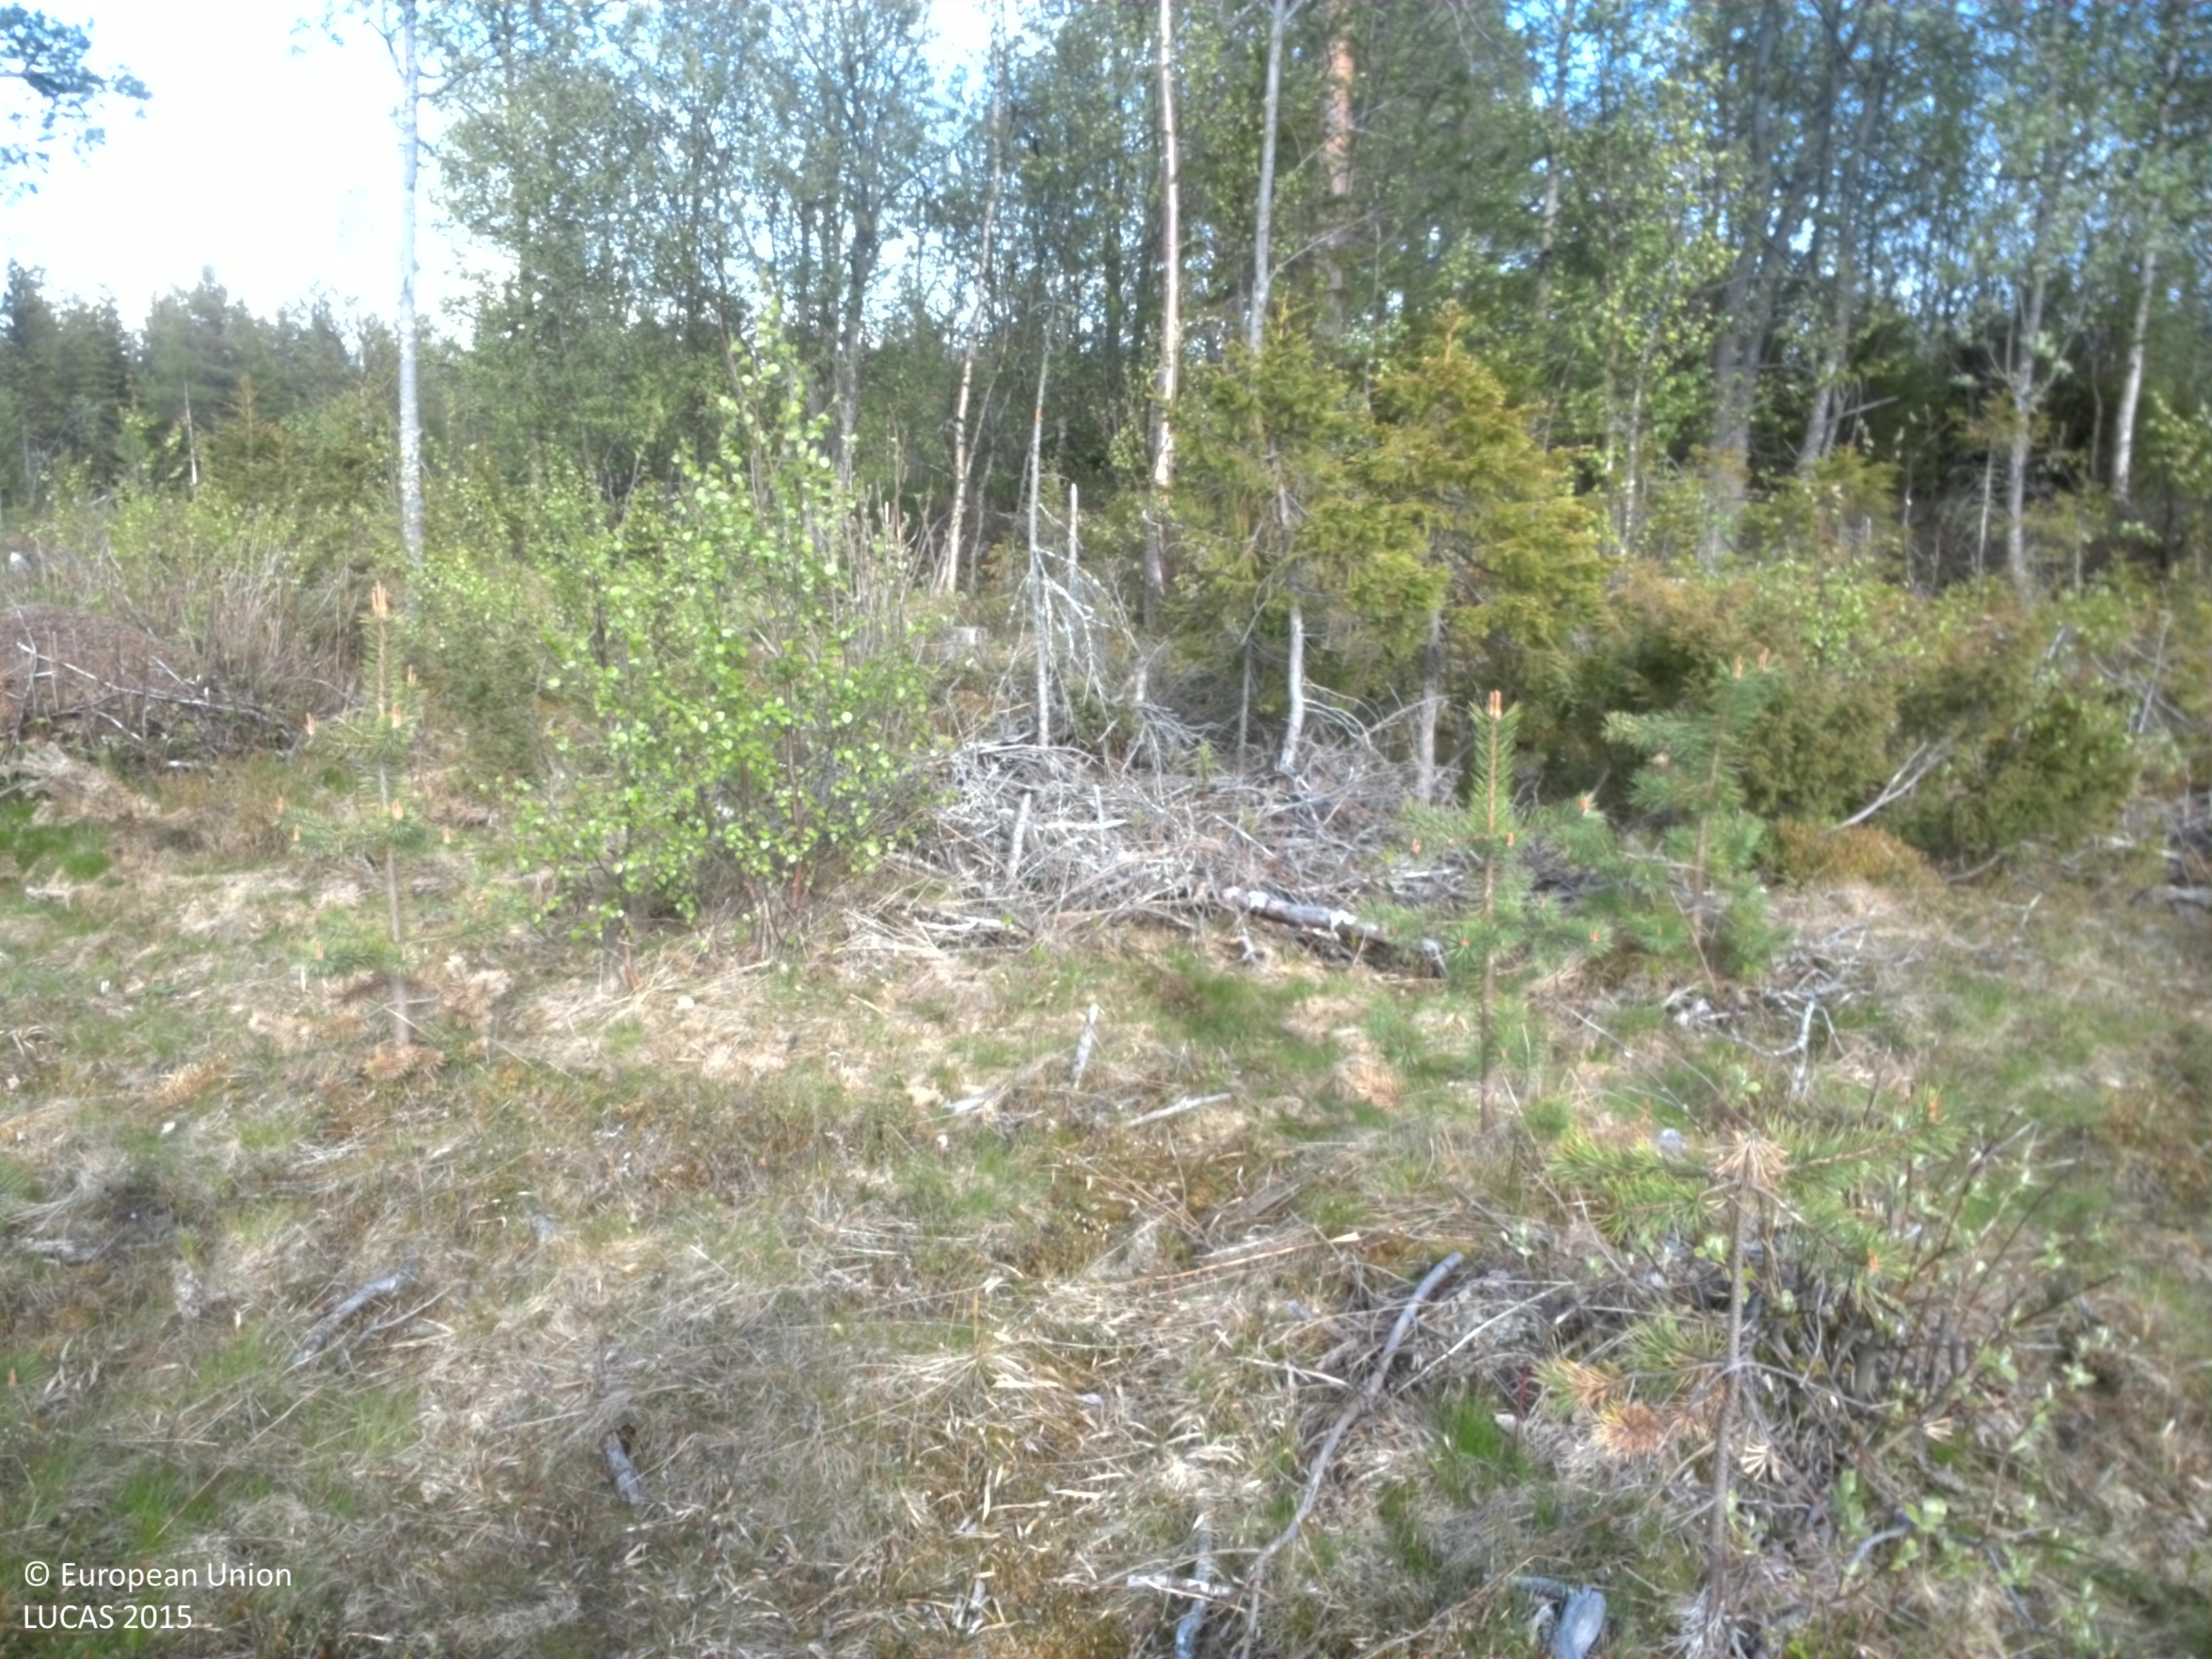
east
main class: Shrubland
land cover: Shrubland with sparse tree cover
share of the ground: 10 - 25 %
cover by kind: herbaceous plants 60 %, lichens and mosses 20 %, shrubs 15 %, broadleaved forest trees 5 %
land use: Forestry
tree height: < 5 m
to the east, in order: Shrubland with sparse tree cover; Pine dominated mixed woodland; Broadleaved woodland; Shrubland with sparse tree cover; Ditches and canals; Shruby margins; Paved roads, cycling and walking lanes; Shruby margins; Ditches and canals; Spruce dominated mixed woodland; Pine dominated mixed woodland; Broadleaved woodland; Spruce dominated mixed woodland; Pine dominated mixed woodland
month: June
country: SE
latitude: 66.8683
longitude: 22.3518
